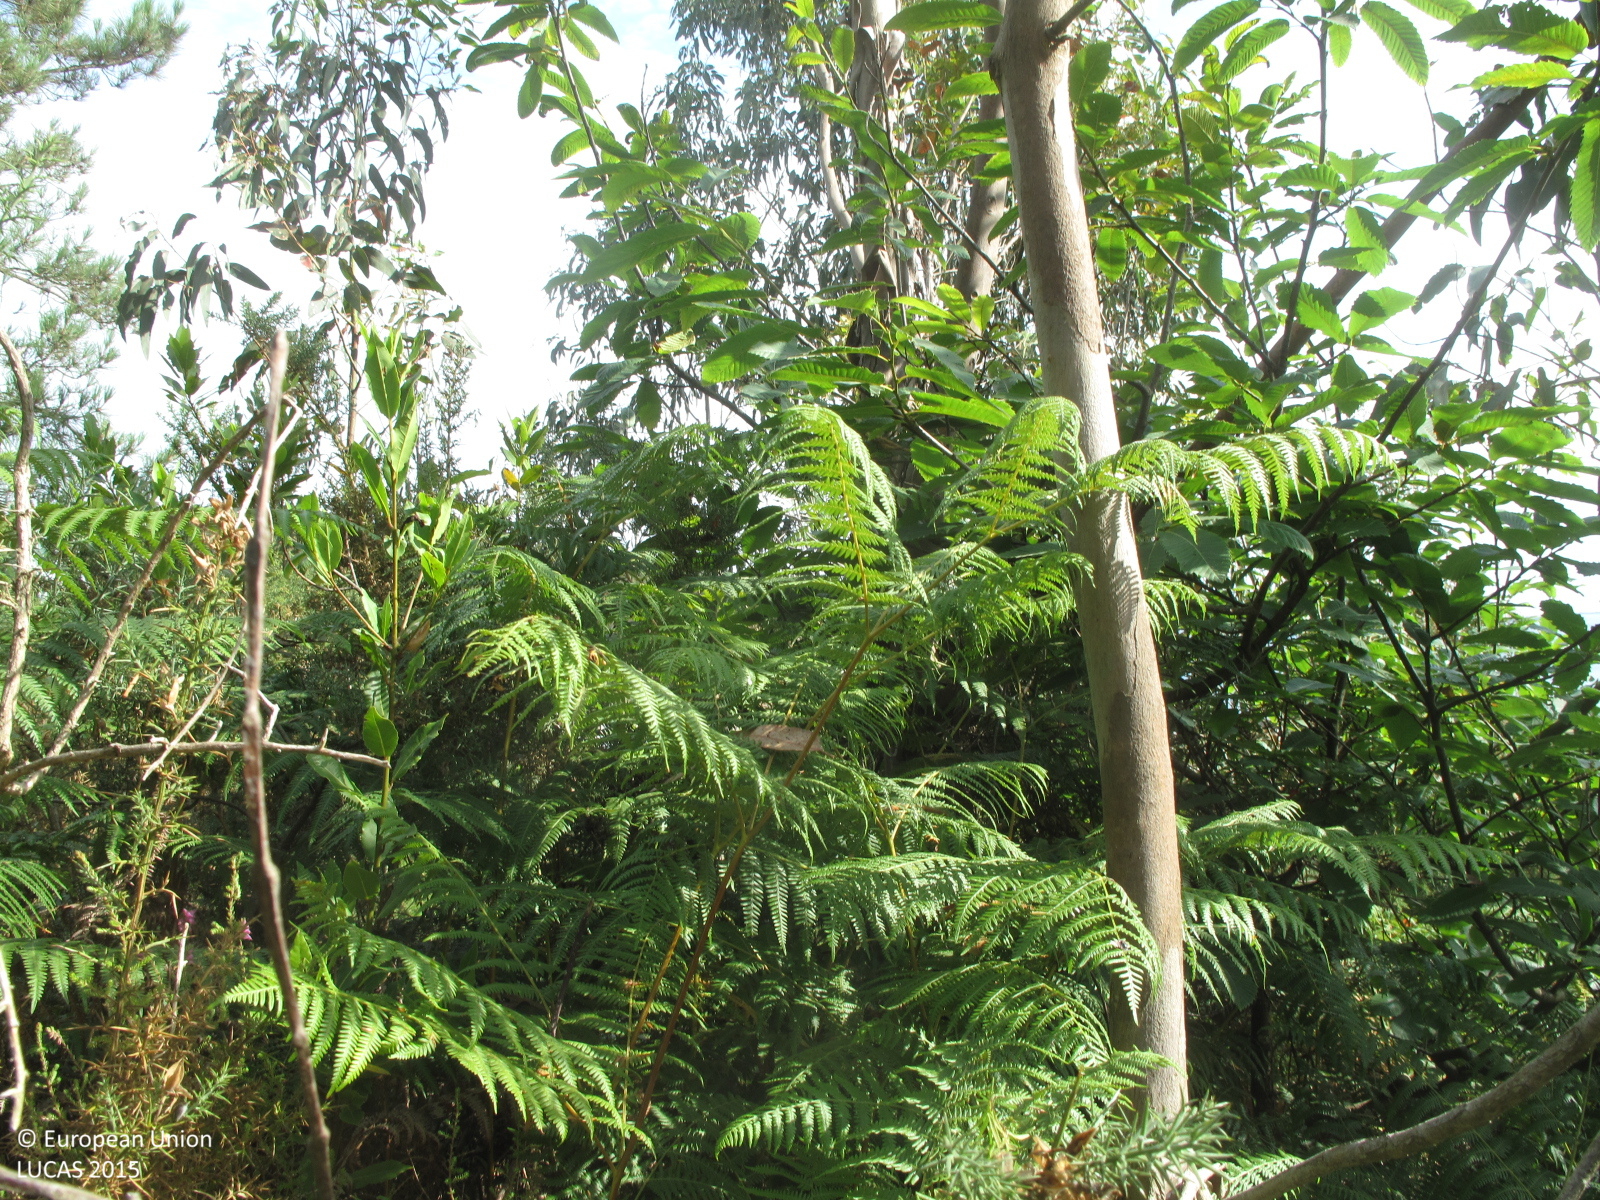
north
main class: Woodland
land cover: Other mixed woodland
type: exotic forest
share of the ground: 25 - 50 %
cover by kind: broadleaved forest trees 30 %, shrubs 30 %, coniferous forest trees 20 %, herbaceous plants 20 %
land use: Forestry
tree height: > 5 m
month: July
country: ES
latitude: 43.3035
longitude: -8.5655
